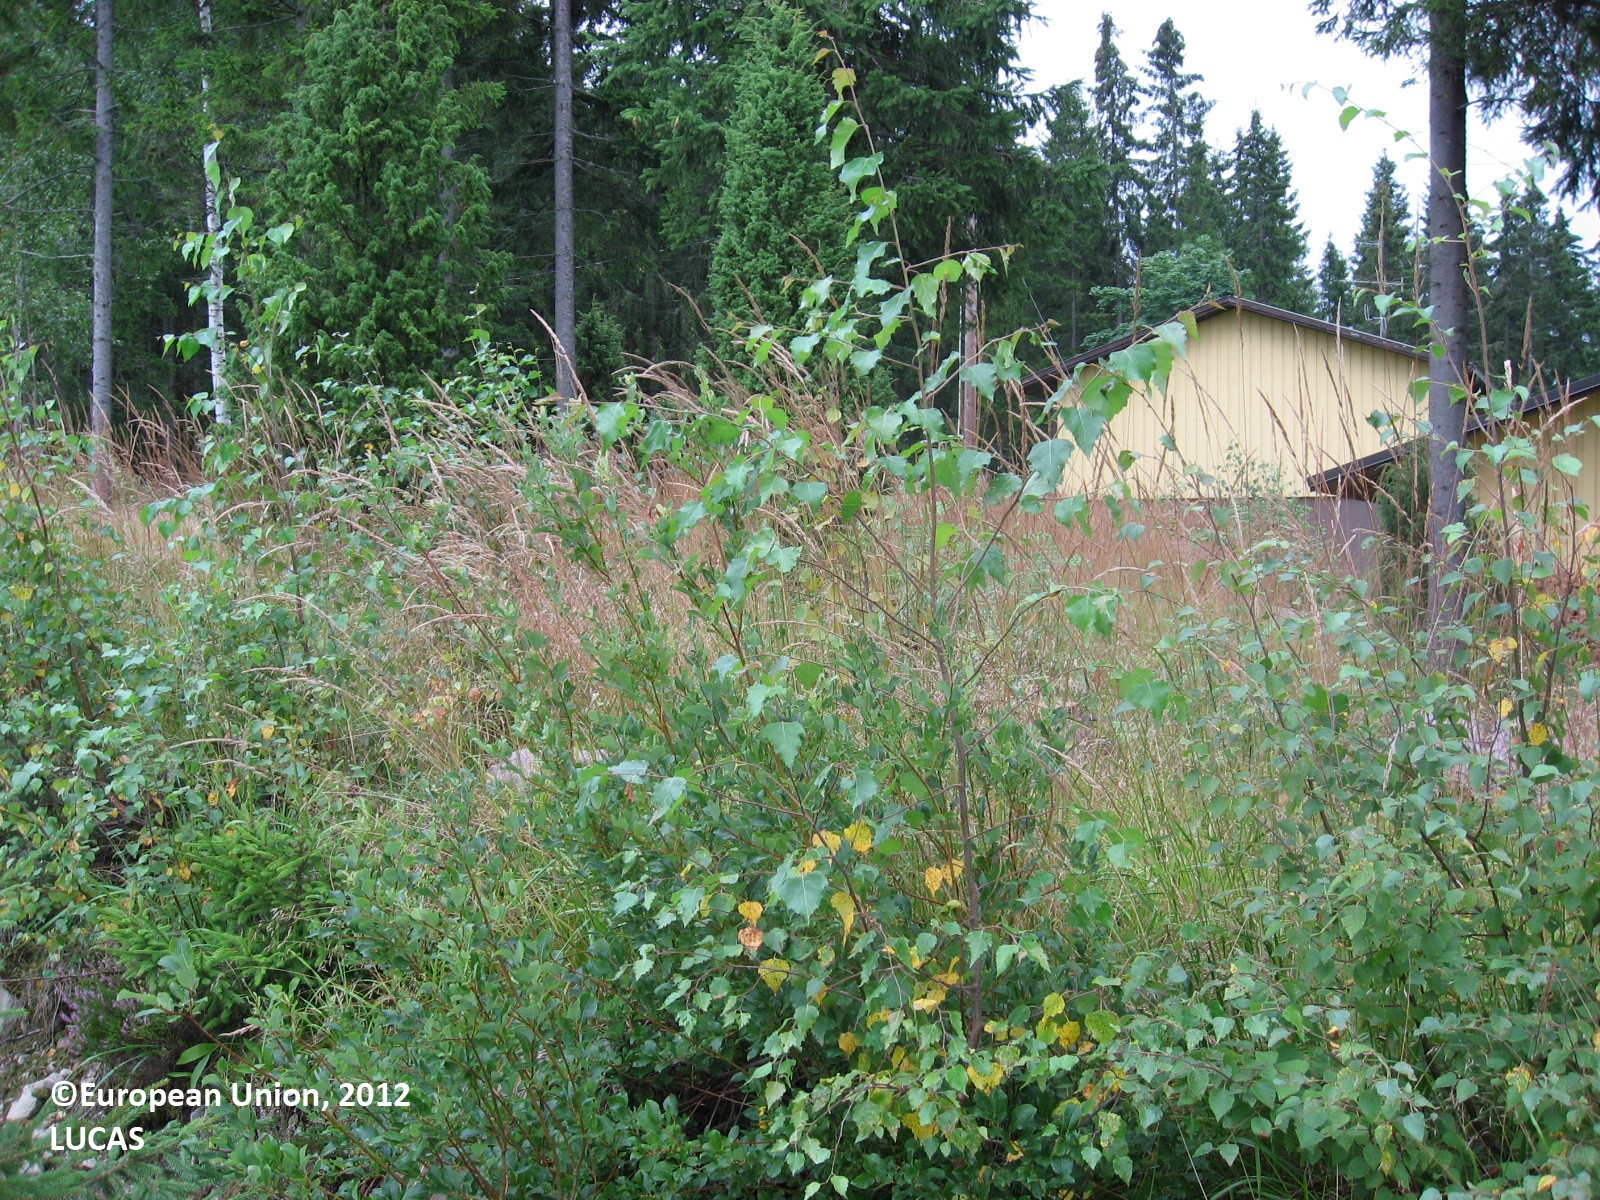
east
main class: Cropland
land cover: Oats
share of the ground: > 75 %
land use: Agriculture (excluding fallow land and kitchen gardens)
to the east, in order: Oats; Electric lines; Ditches and canals; Grass margins; Other mixed woodland; Artificial constructions in urban areas; Spruce dominated coniferous woodland
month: August
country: FI
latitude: 60.6191
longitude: 25.5330
